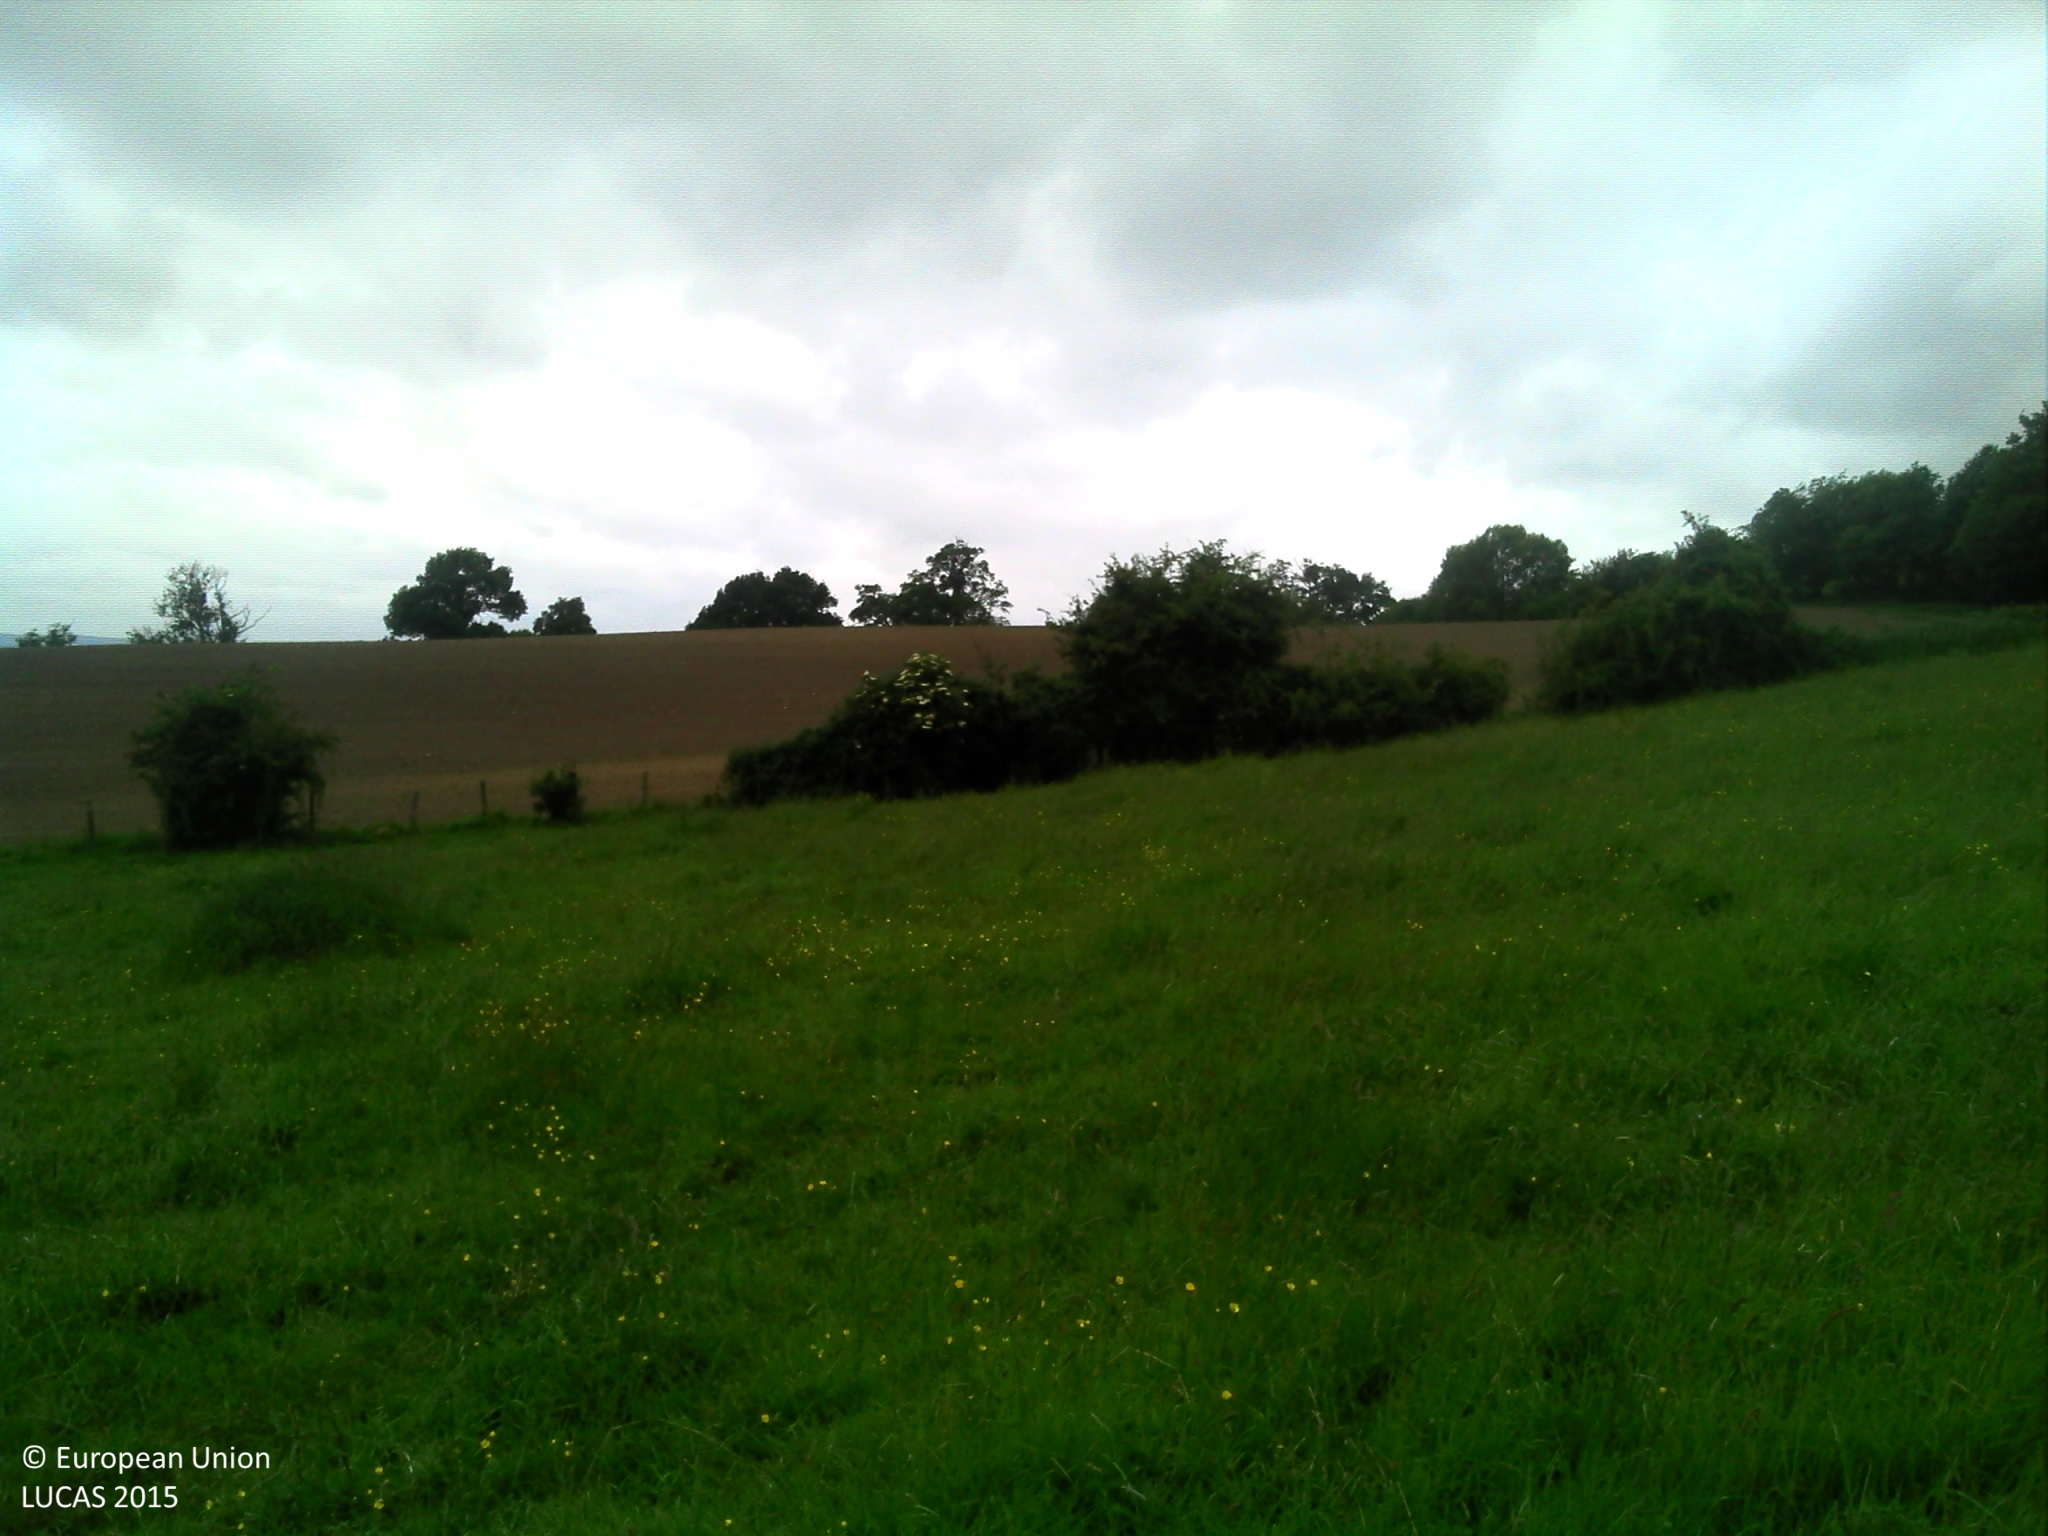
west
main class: Grassland
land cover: Grassland without tree/shrub cover
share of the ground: > 75 %
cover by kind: herbaceous plants 95 %, shrubs 5 %
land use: Agriculture (excluding fallow land and kitchen gardens)
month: June
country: FR
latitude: 48.8657
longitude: 0.1146
